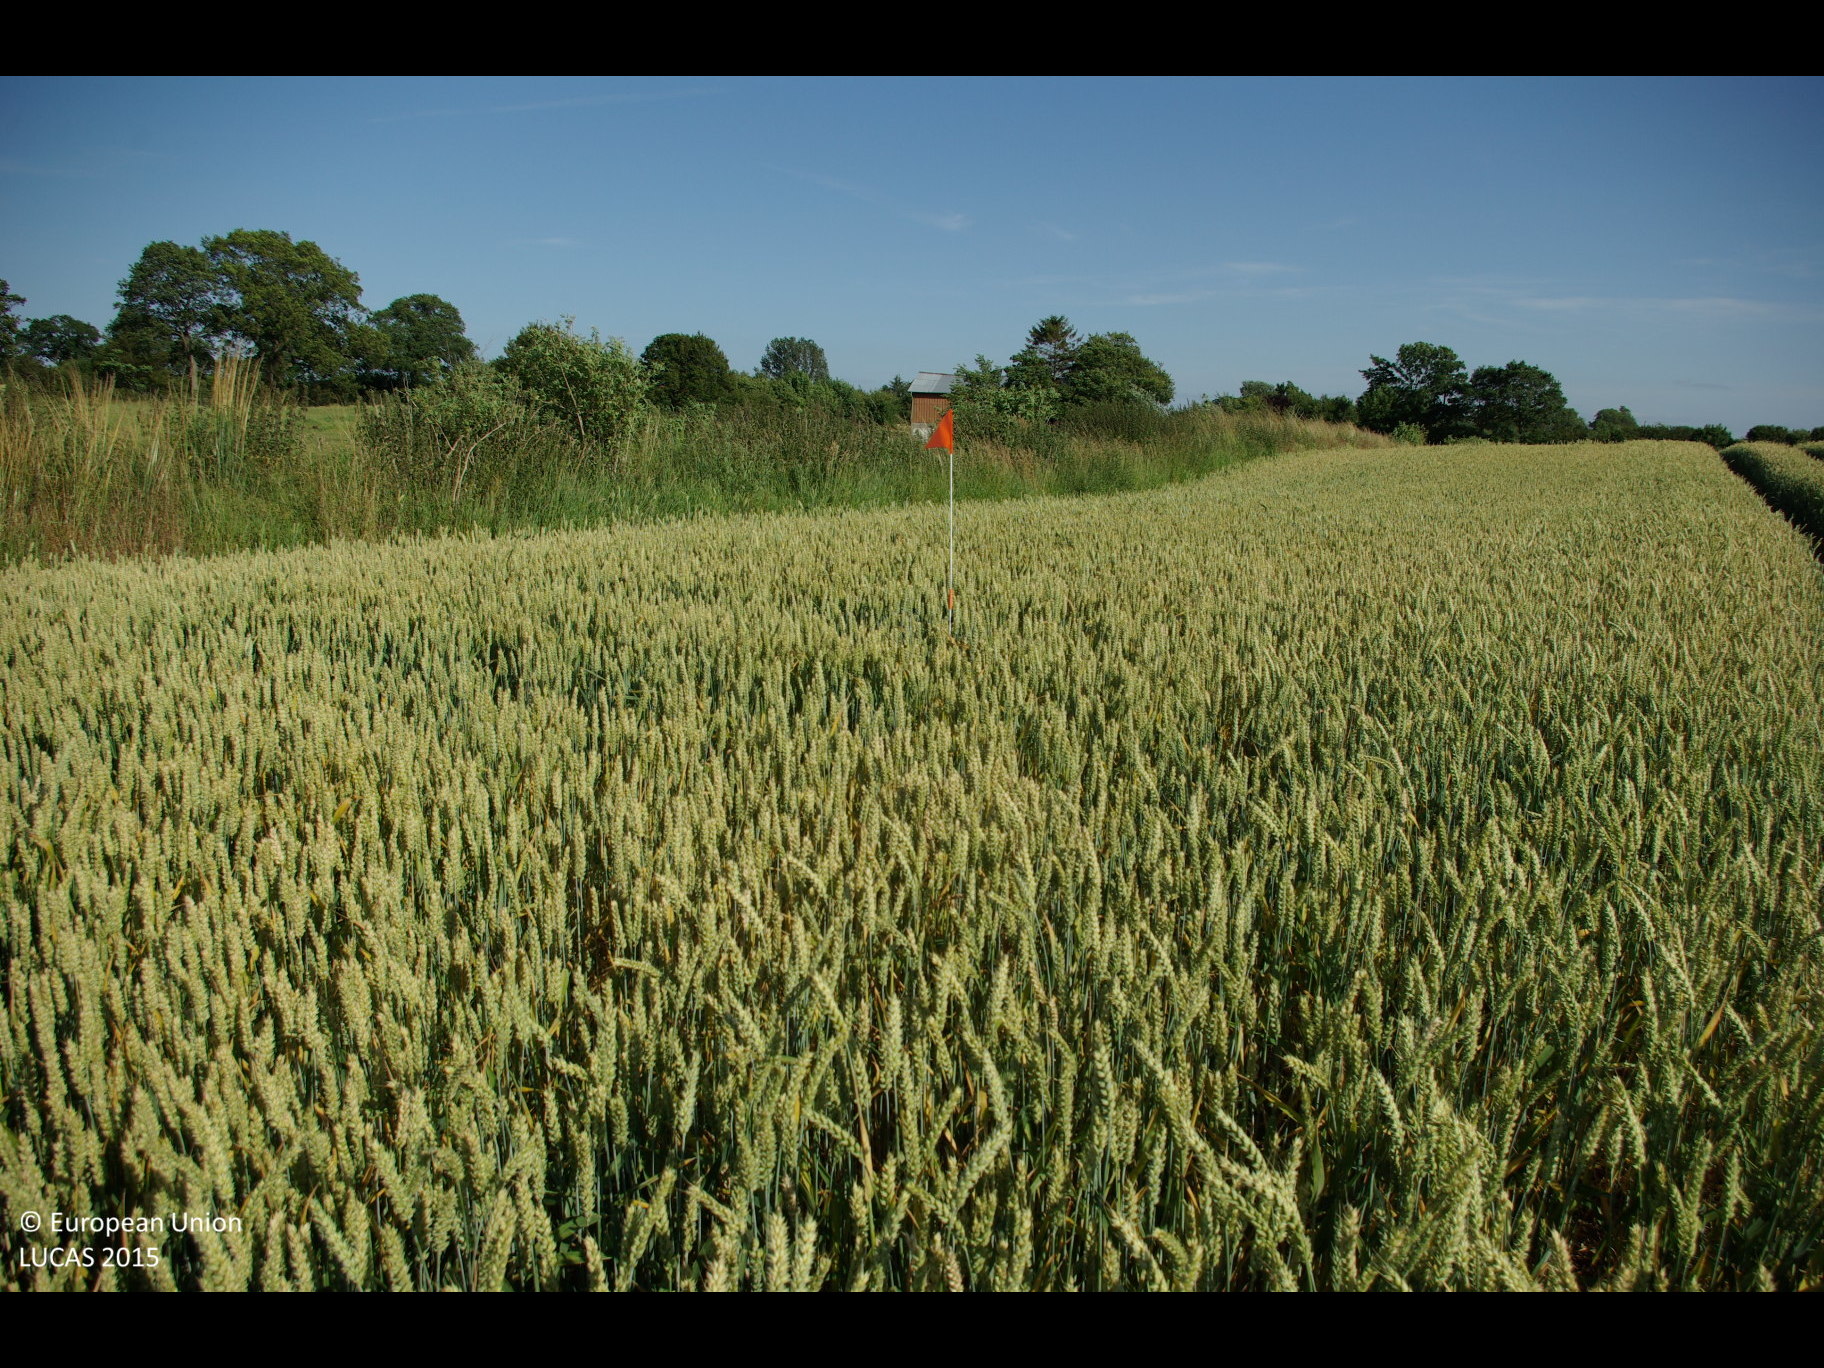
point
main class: Cropland
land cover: Common wheat
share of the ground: > 75 %
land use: Agriculture (excluding fallow land and kitchen gardens)
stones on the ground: 10 - 25 %
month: July
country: DE
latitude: 54.6599
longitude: 9.8606
